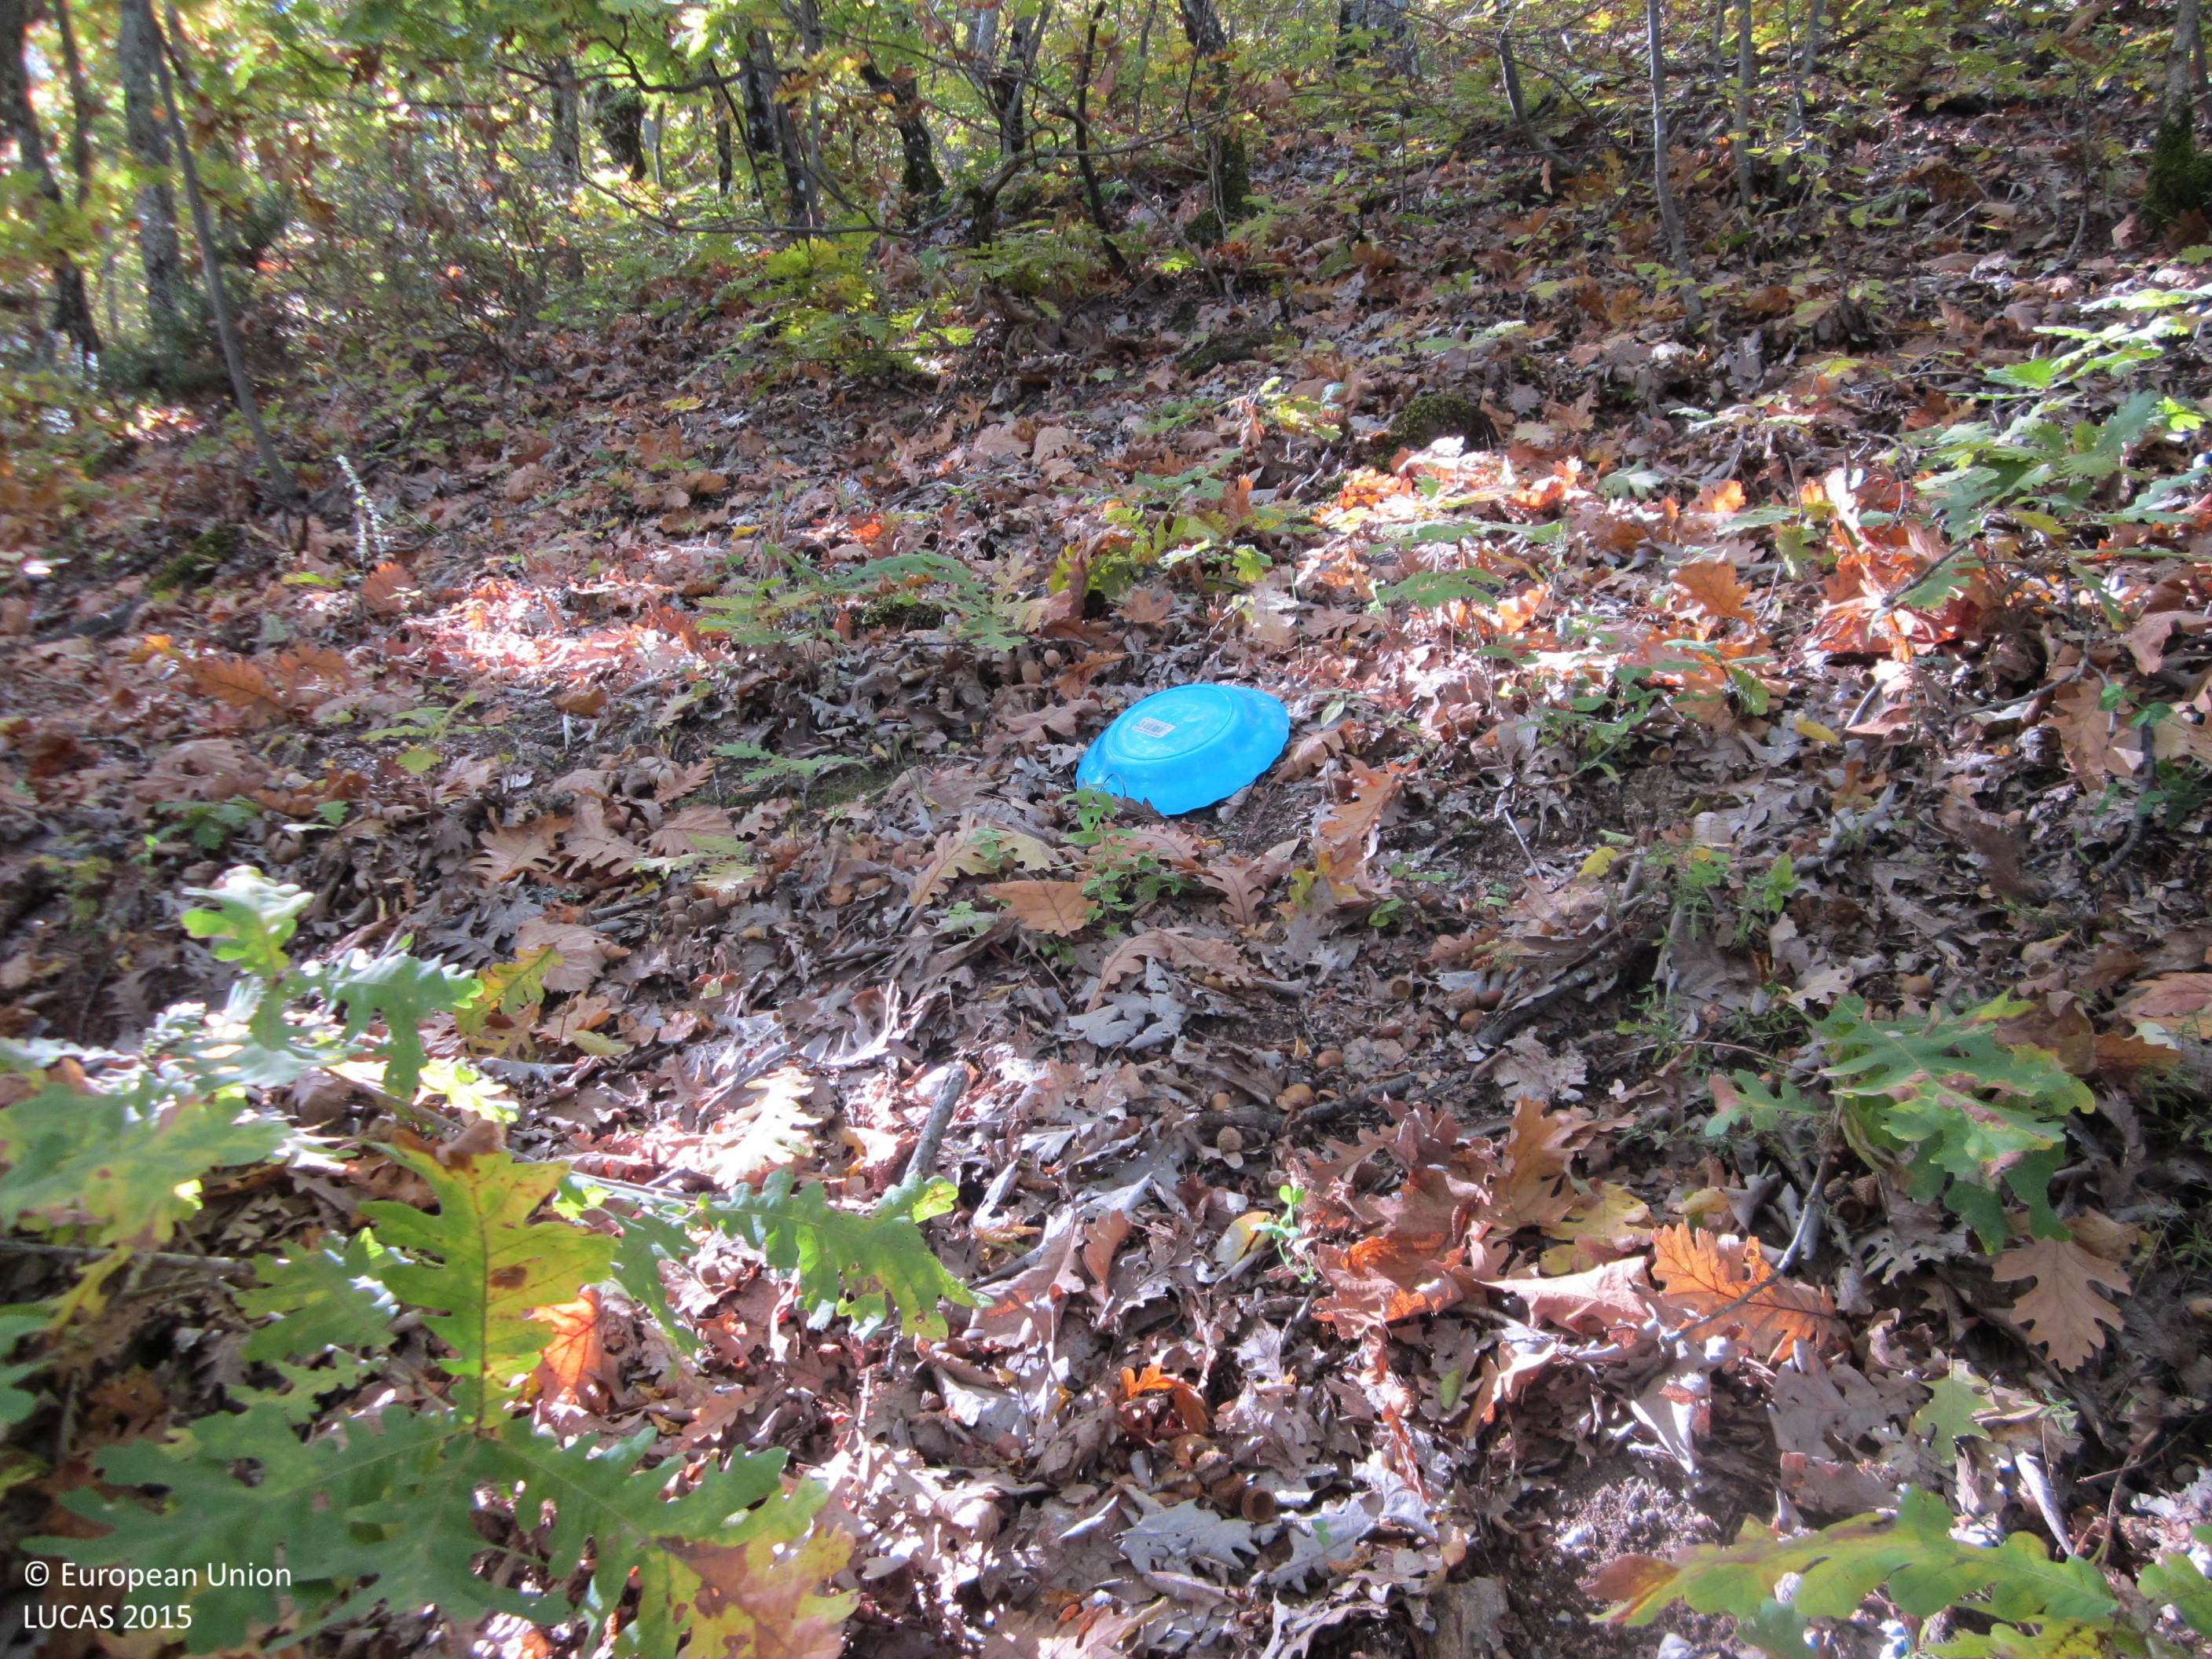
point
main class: Woodland
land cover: Broadleaved woodland
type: thermophilous deciduous forest
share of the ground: > 75 %
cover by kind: broadleaved forest trees 95 %, shrubs 5 %
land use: Forestry
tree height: > 5 m
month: November
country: BG
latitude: 41.4274
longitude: 25.7736
